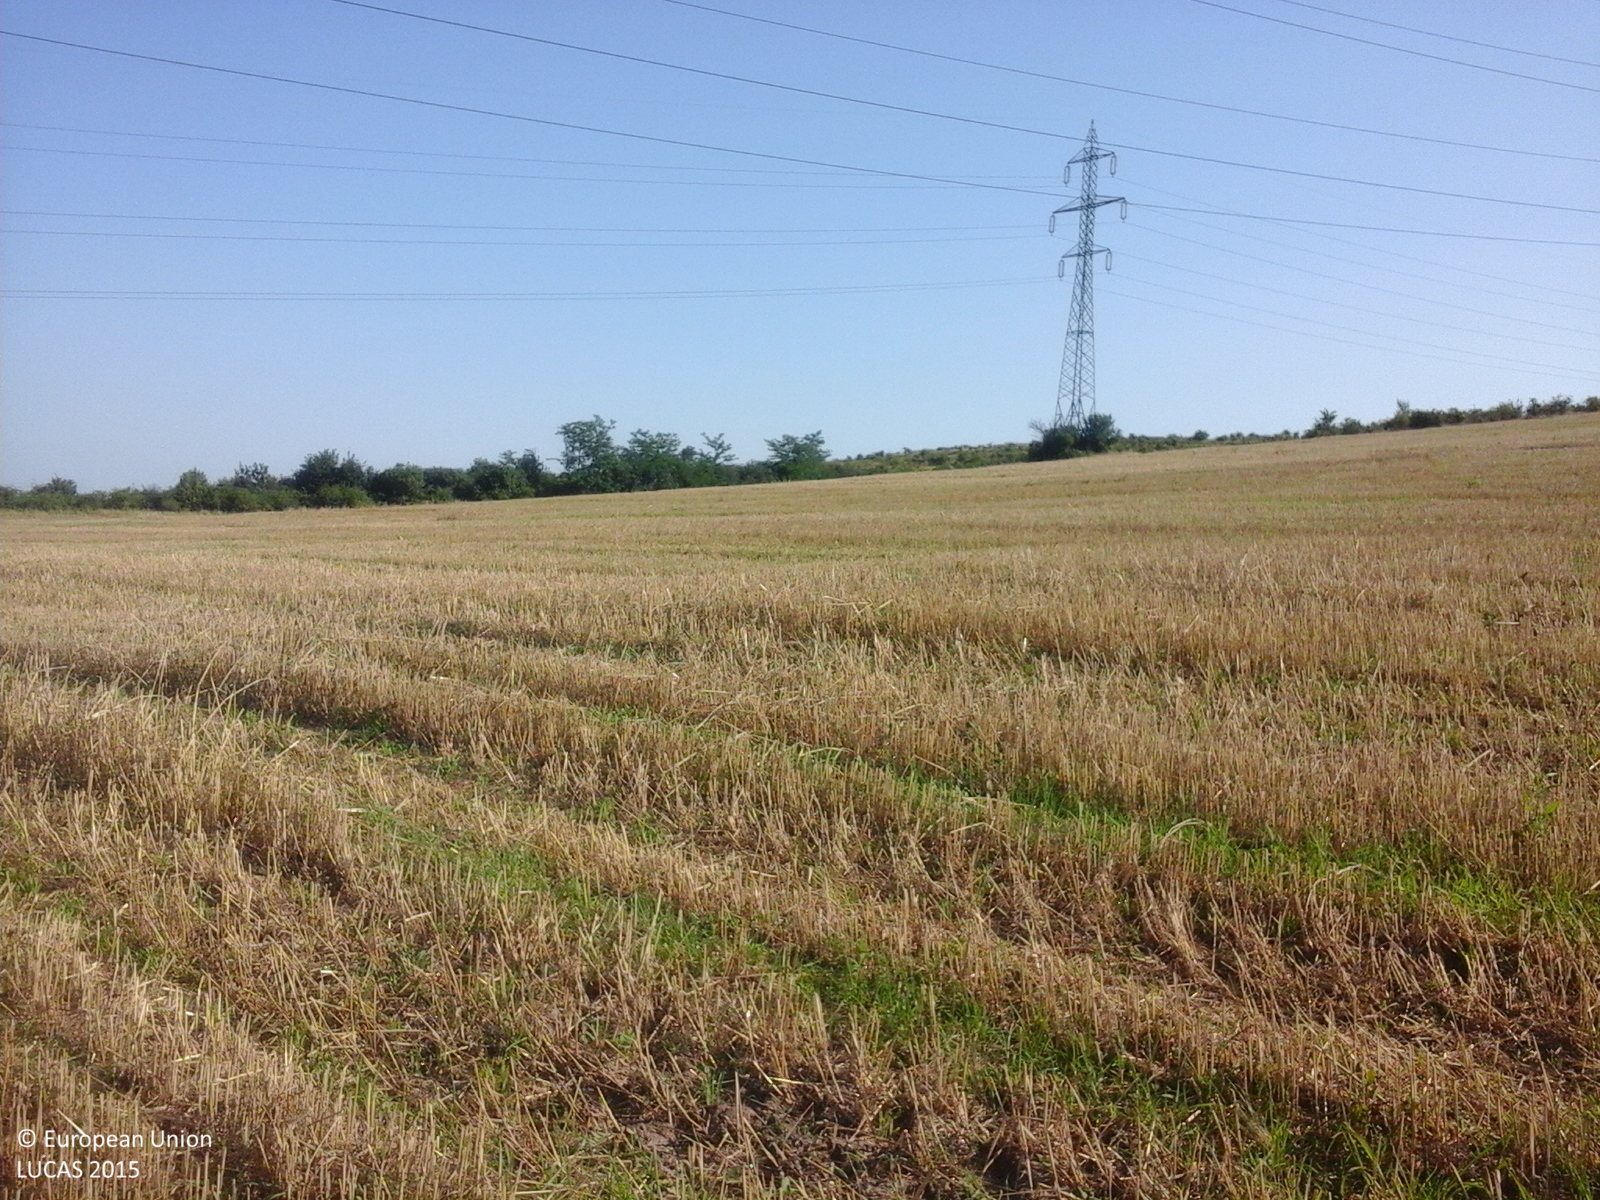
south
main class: Cropland
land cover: Common wheat
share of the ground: > 75 %
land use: Agriculture (excluding fallow land and kitchen gardens)
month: July
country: RO
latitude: 44.4260
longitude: 24.2216
